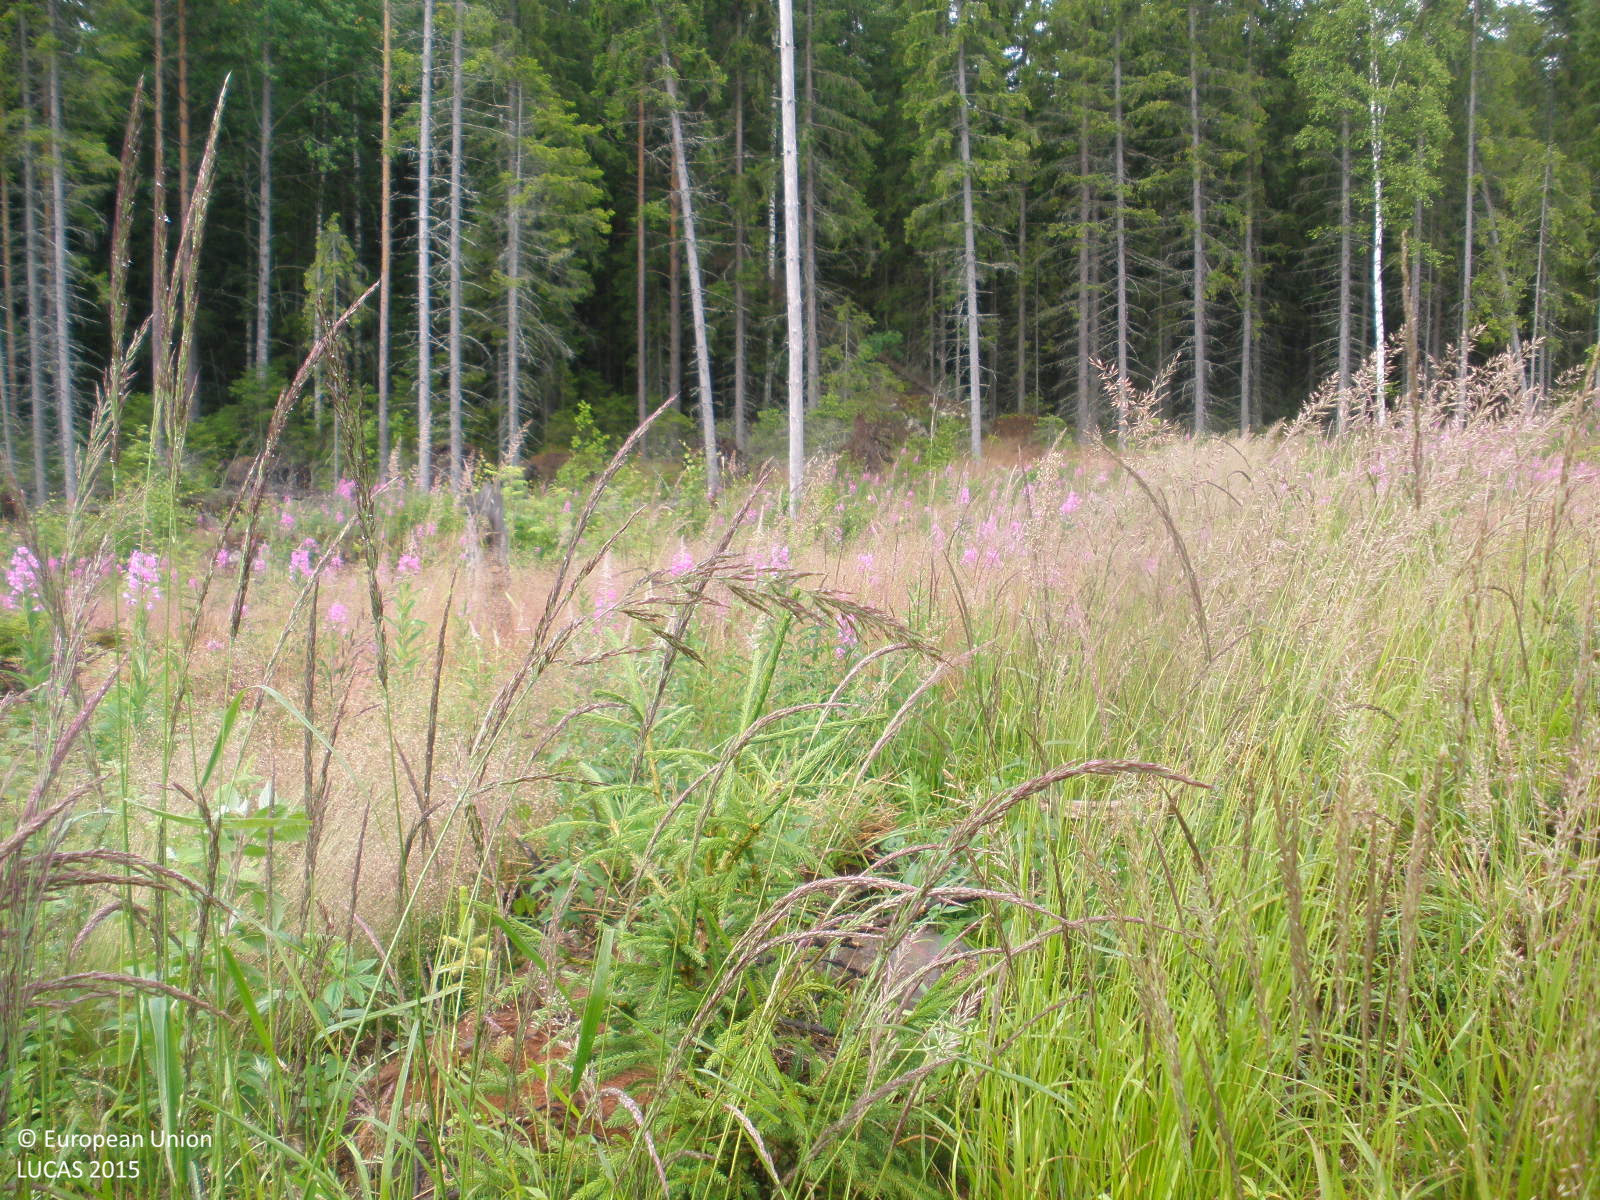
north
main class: Woodland
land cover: Other mixed woodland
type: boreal forest
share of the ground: 10 - 25 %
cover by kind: herbaceous plants 60 %, lichens and mosses 15 %, shrubs 10 %, coniferous forest trees 5 %, broadleaved forest trees 5 %, unconsolidated bare surface 5 %
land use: Forestry
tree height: < 5 m
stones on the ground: > 50 %
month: July
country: FI
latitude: 61.4564
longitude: 24.7563
